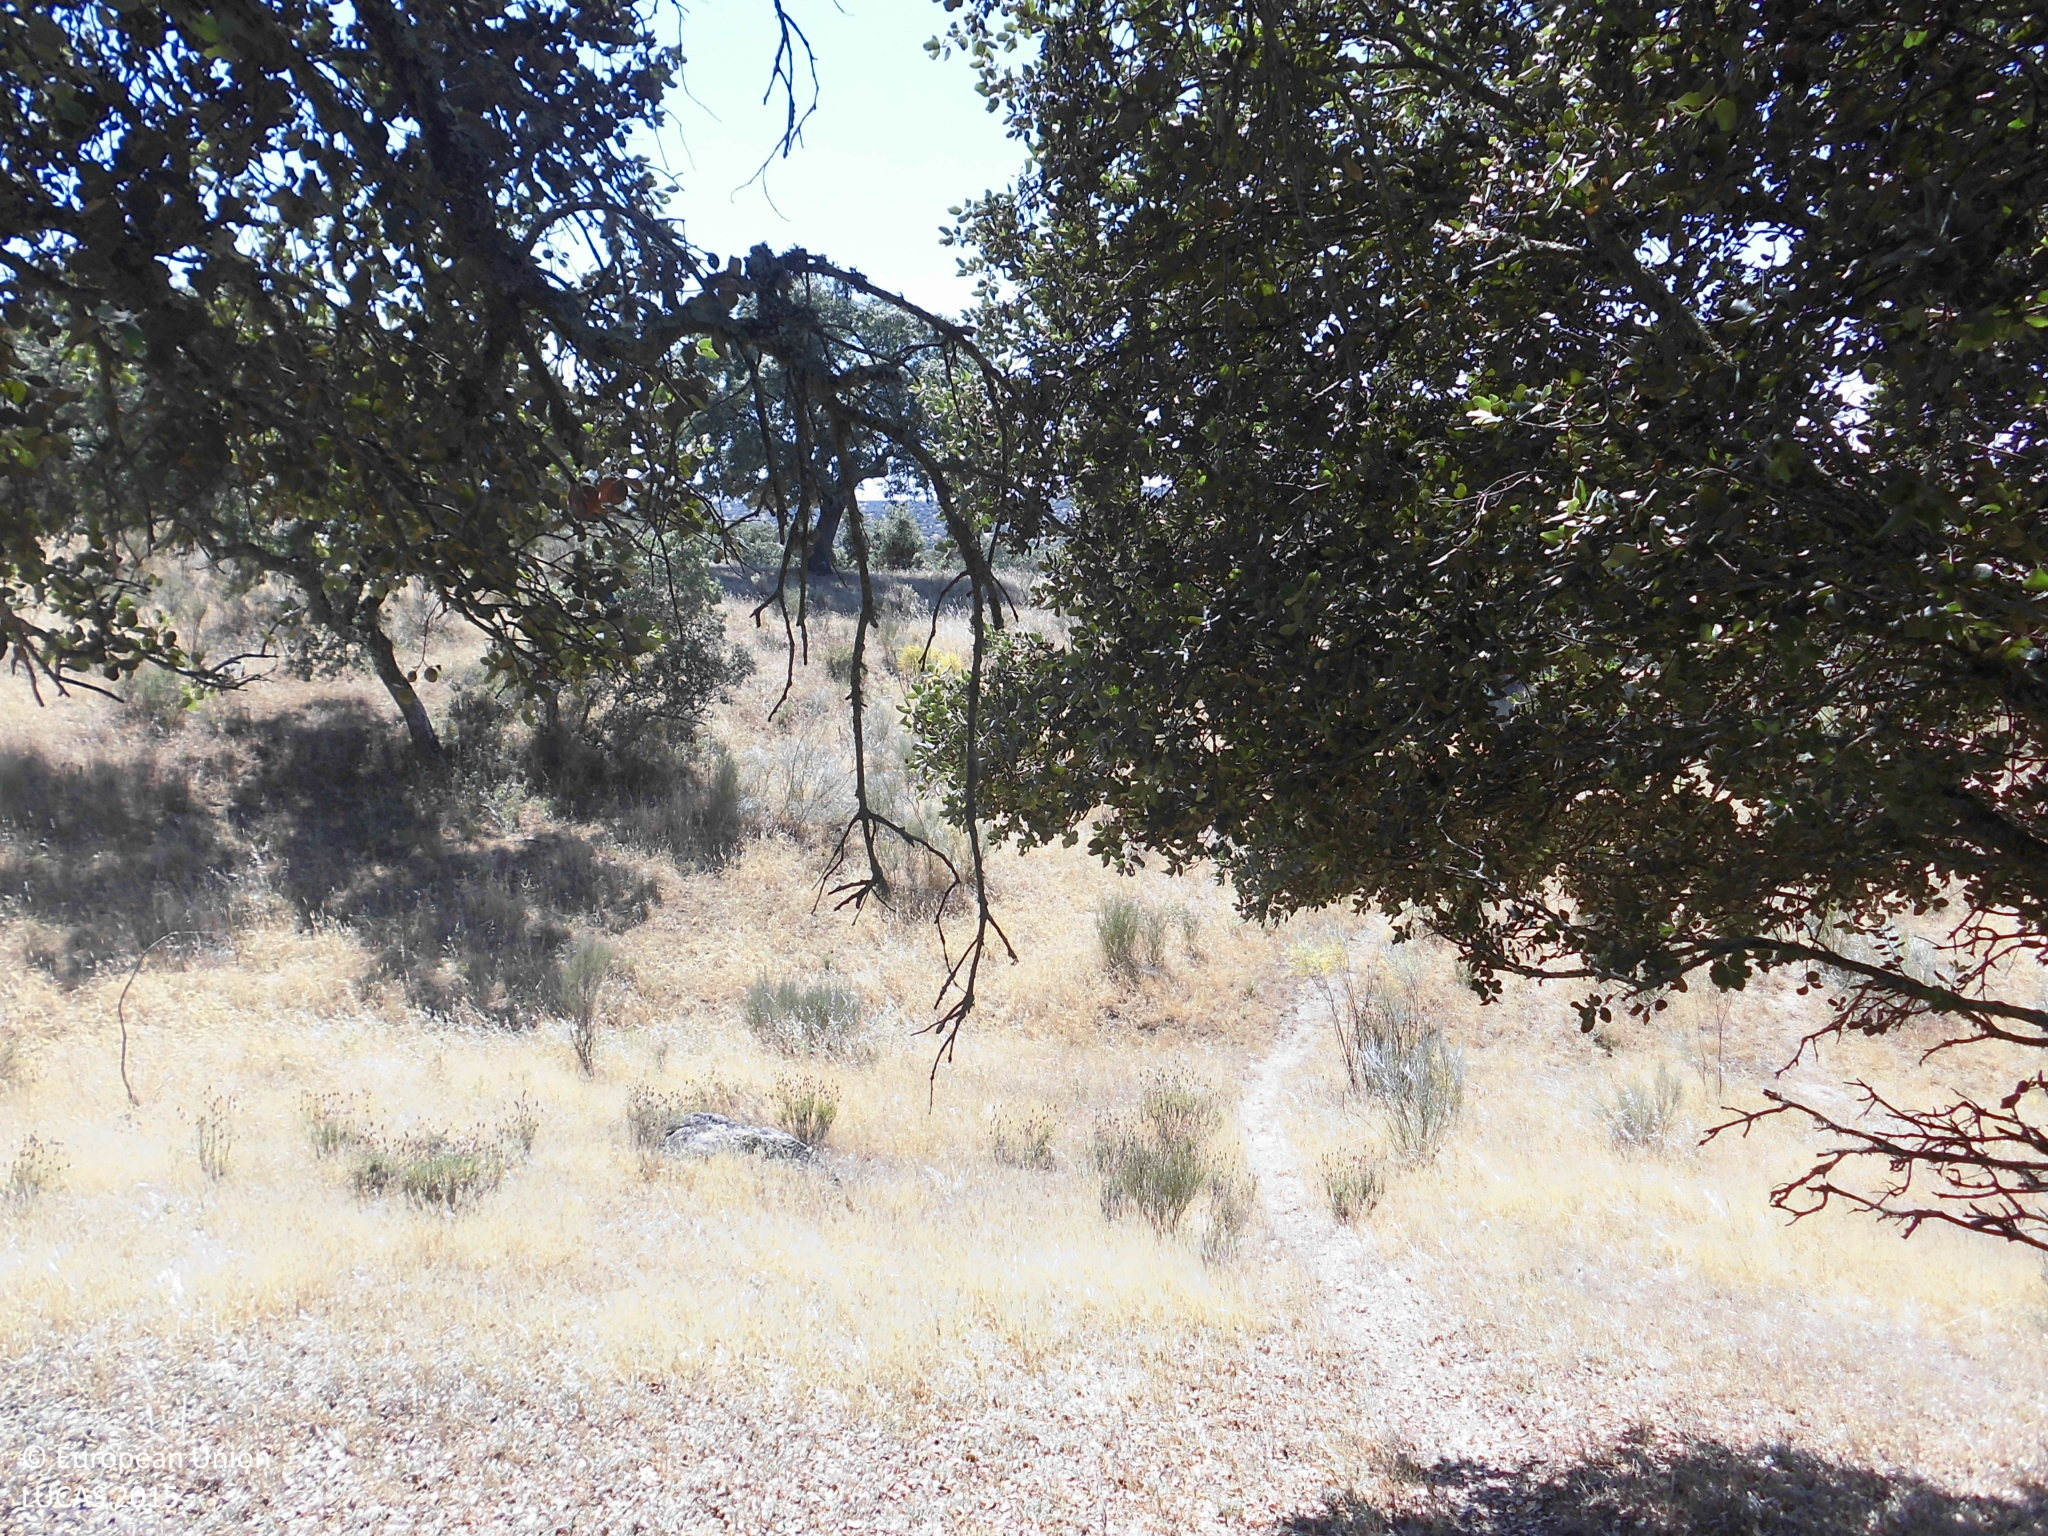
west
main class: Woodland
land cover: Broadleaved woodland
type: broadleaved evergreen forest
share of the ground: 25 - 50 %
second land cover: Grassland without tree/shrub cover
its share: > 75 %
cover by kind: herbaceous plants 65 %, broadleaved forest trees 25 %, shrubs 10 %
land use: Forestry
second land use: Agriculture (excluding fallow land and kitchen gardens)
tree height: > 5 m
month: May
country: ES
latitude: 39.5505
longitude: -6.6584
